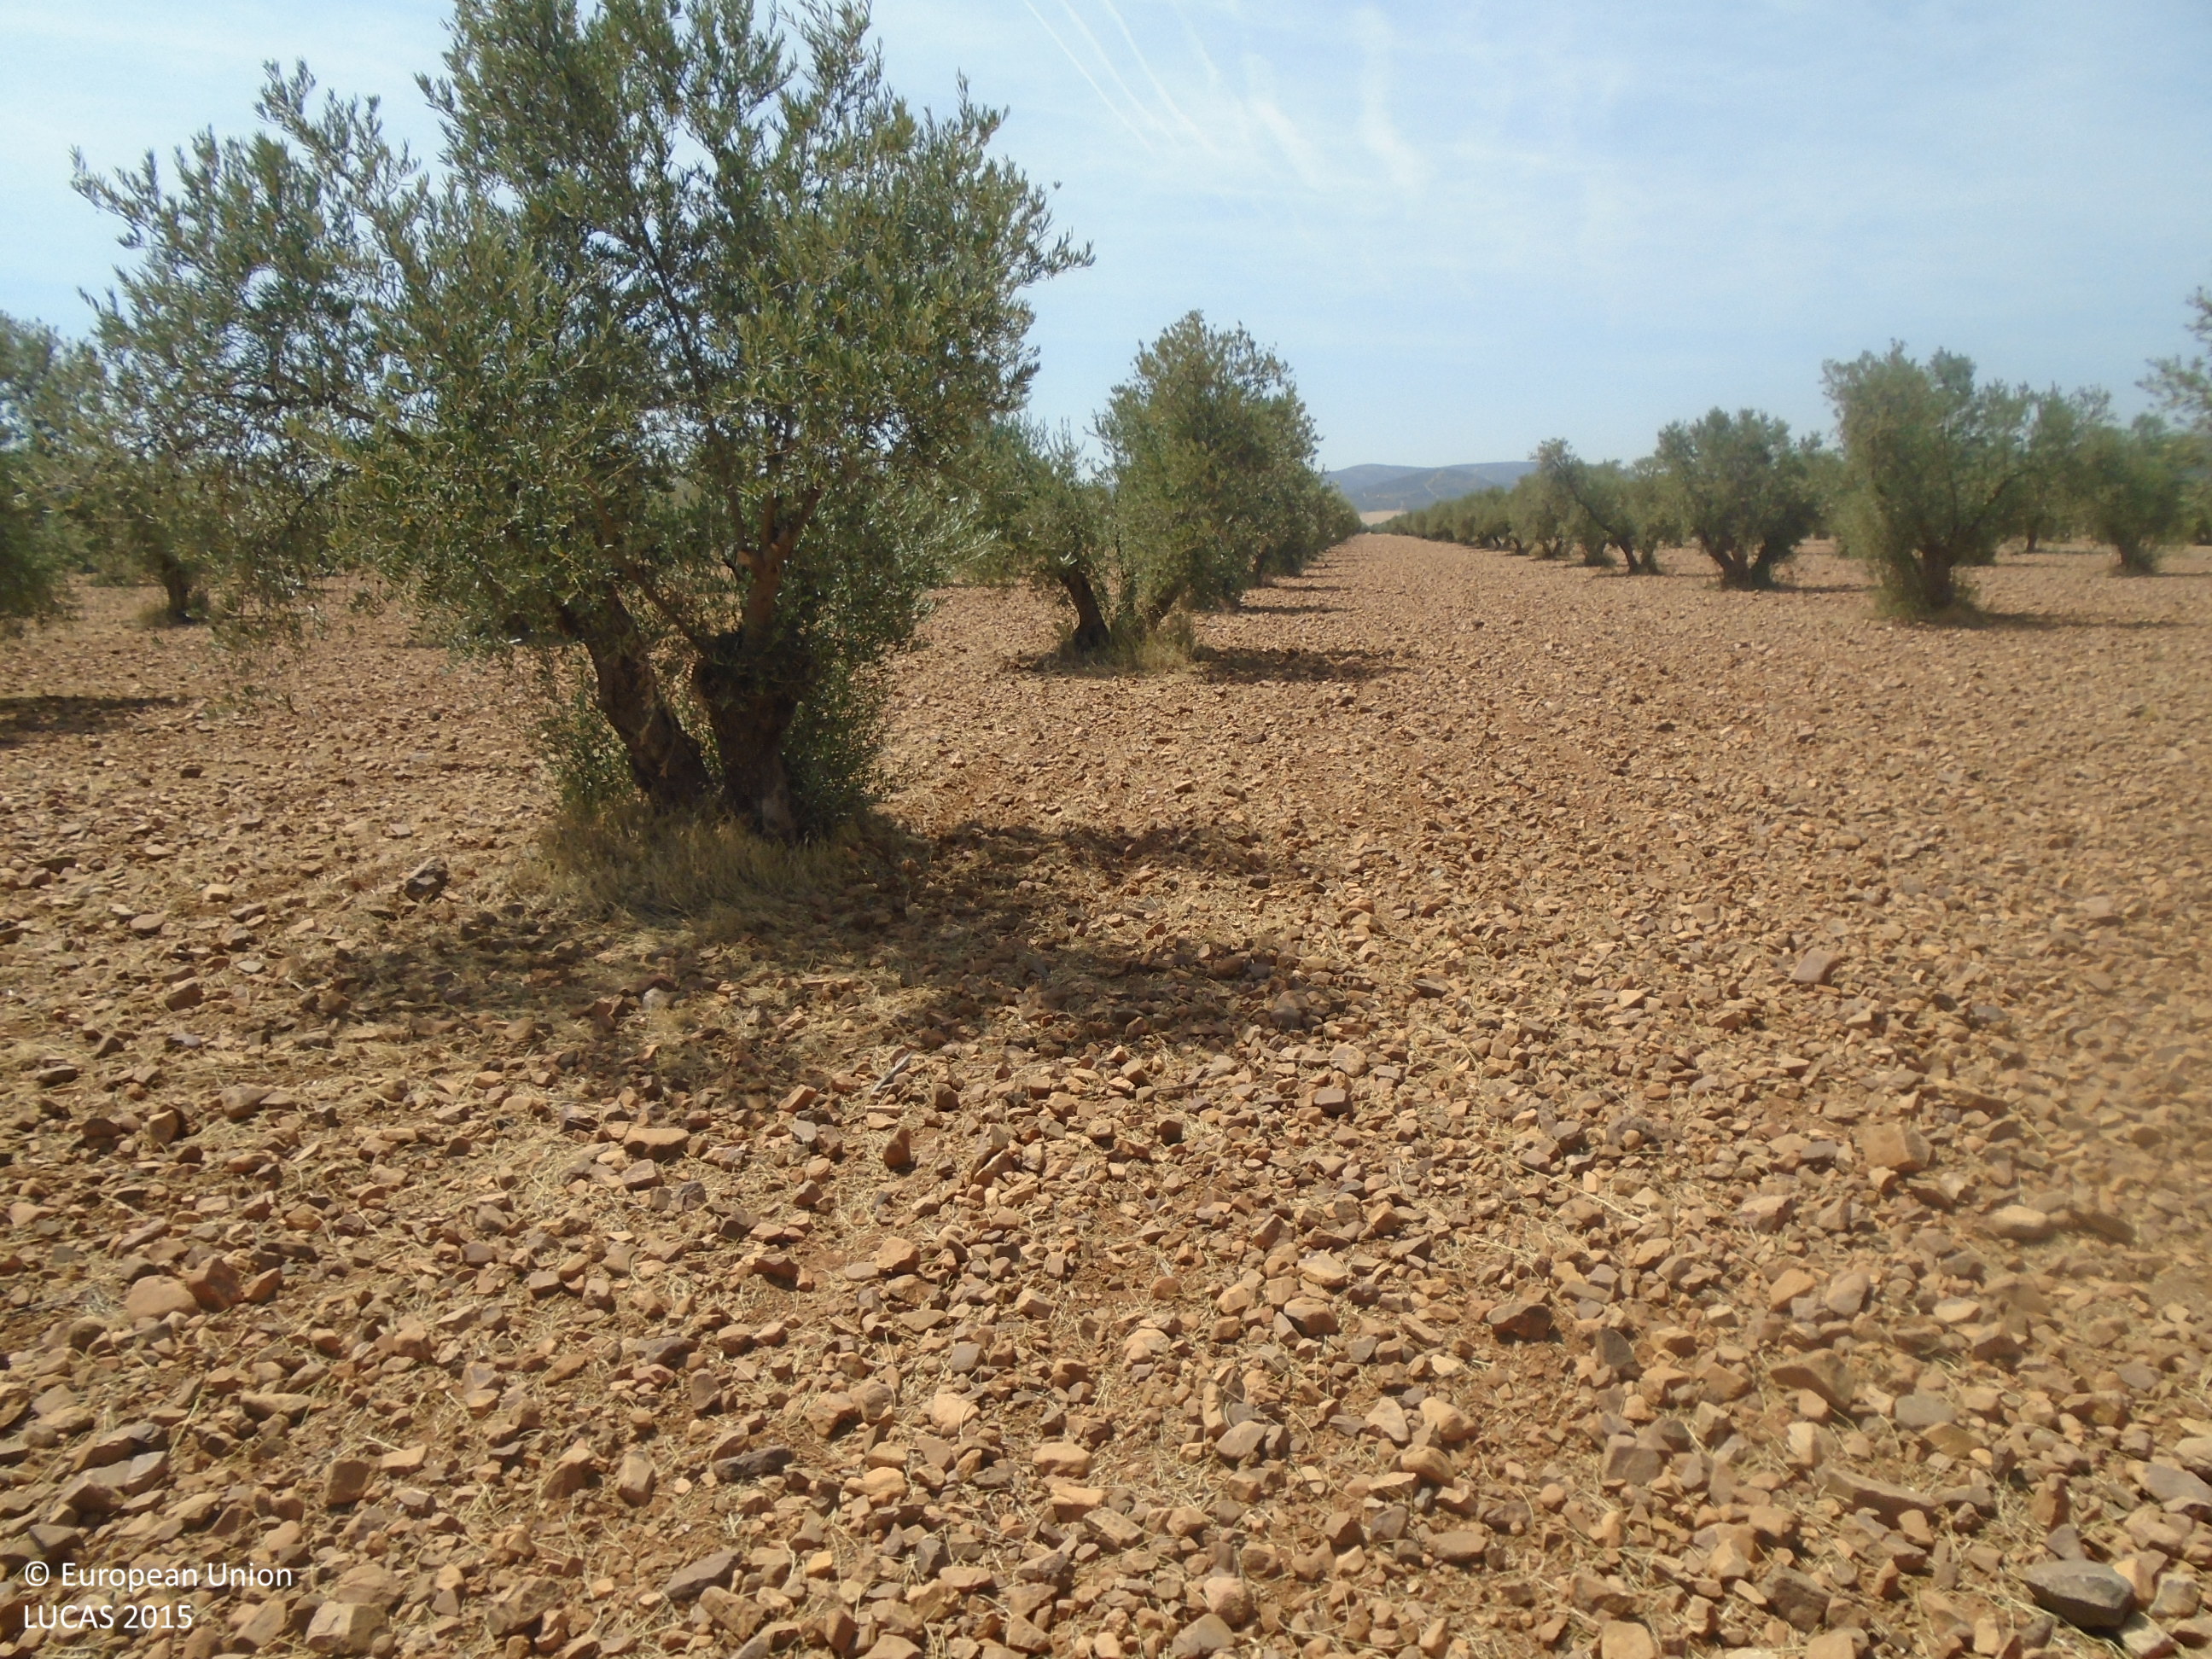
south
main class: Cropland
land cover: Olive groves
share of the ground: 25 - 50 %
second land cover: Other bare soil
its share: > 75 %
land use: Agriculture (excluding fallow land and kitchen gardens)
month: July
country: ES
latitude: 39.4072
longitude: -3.5988
